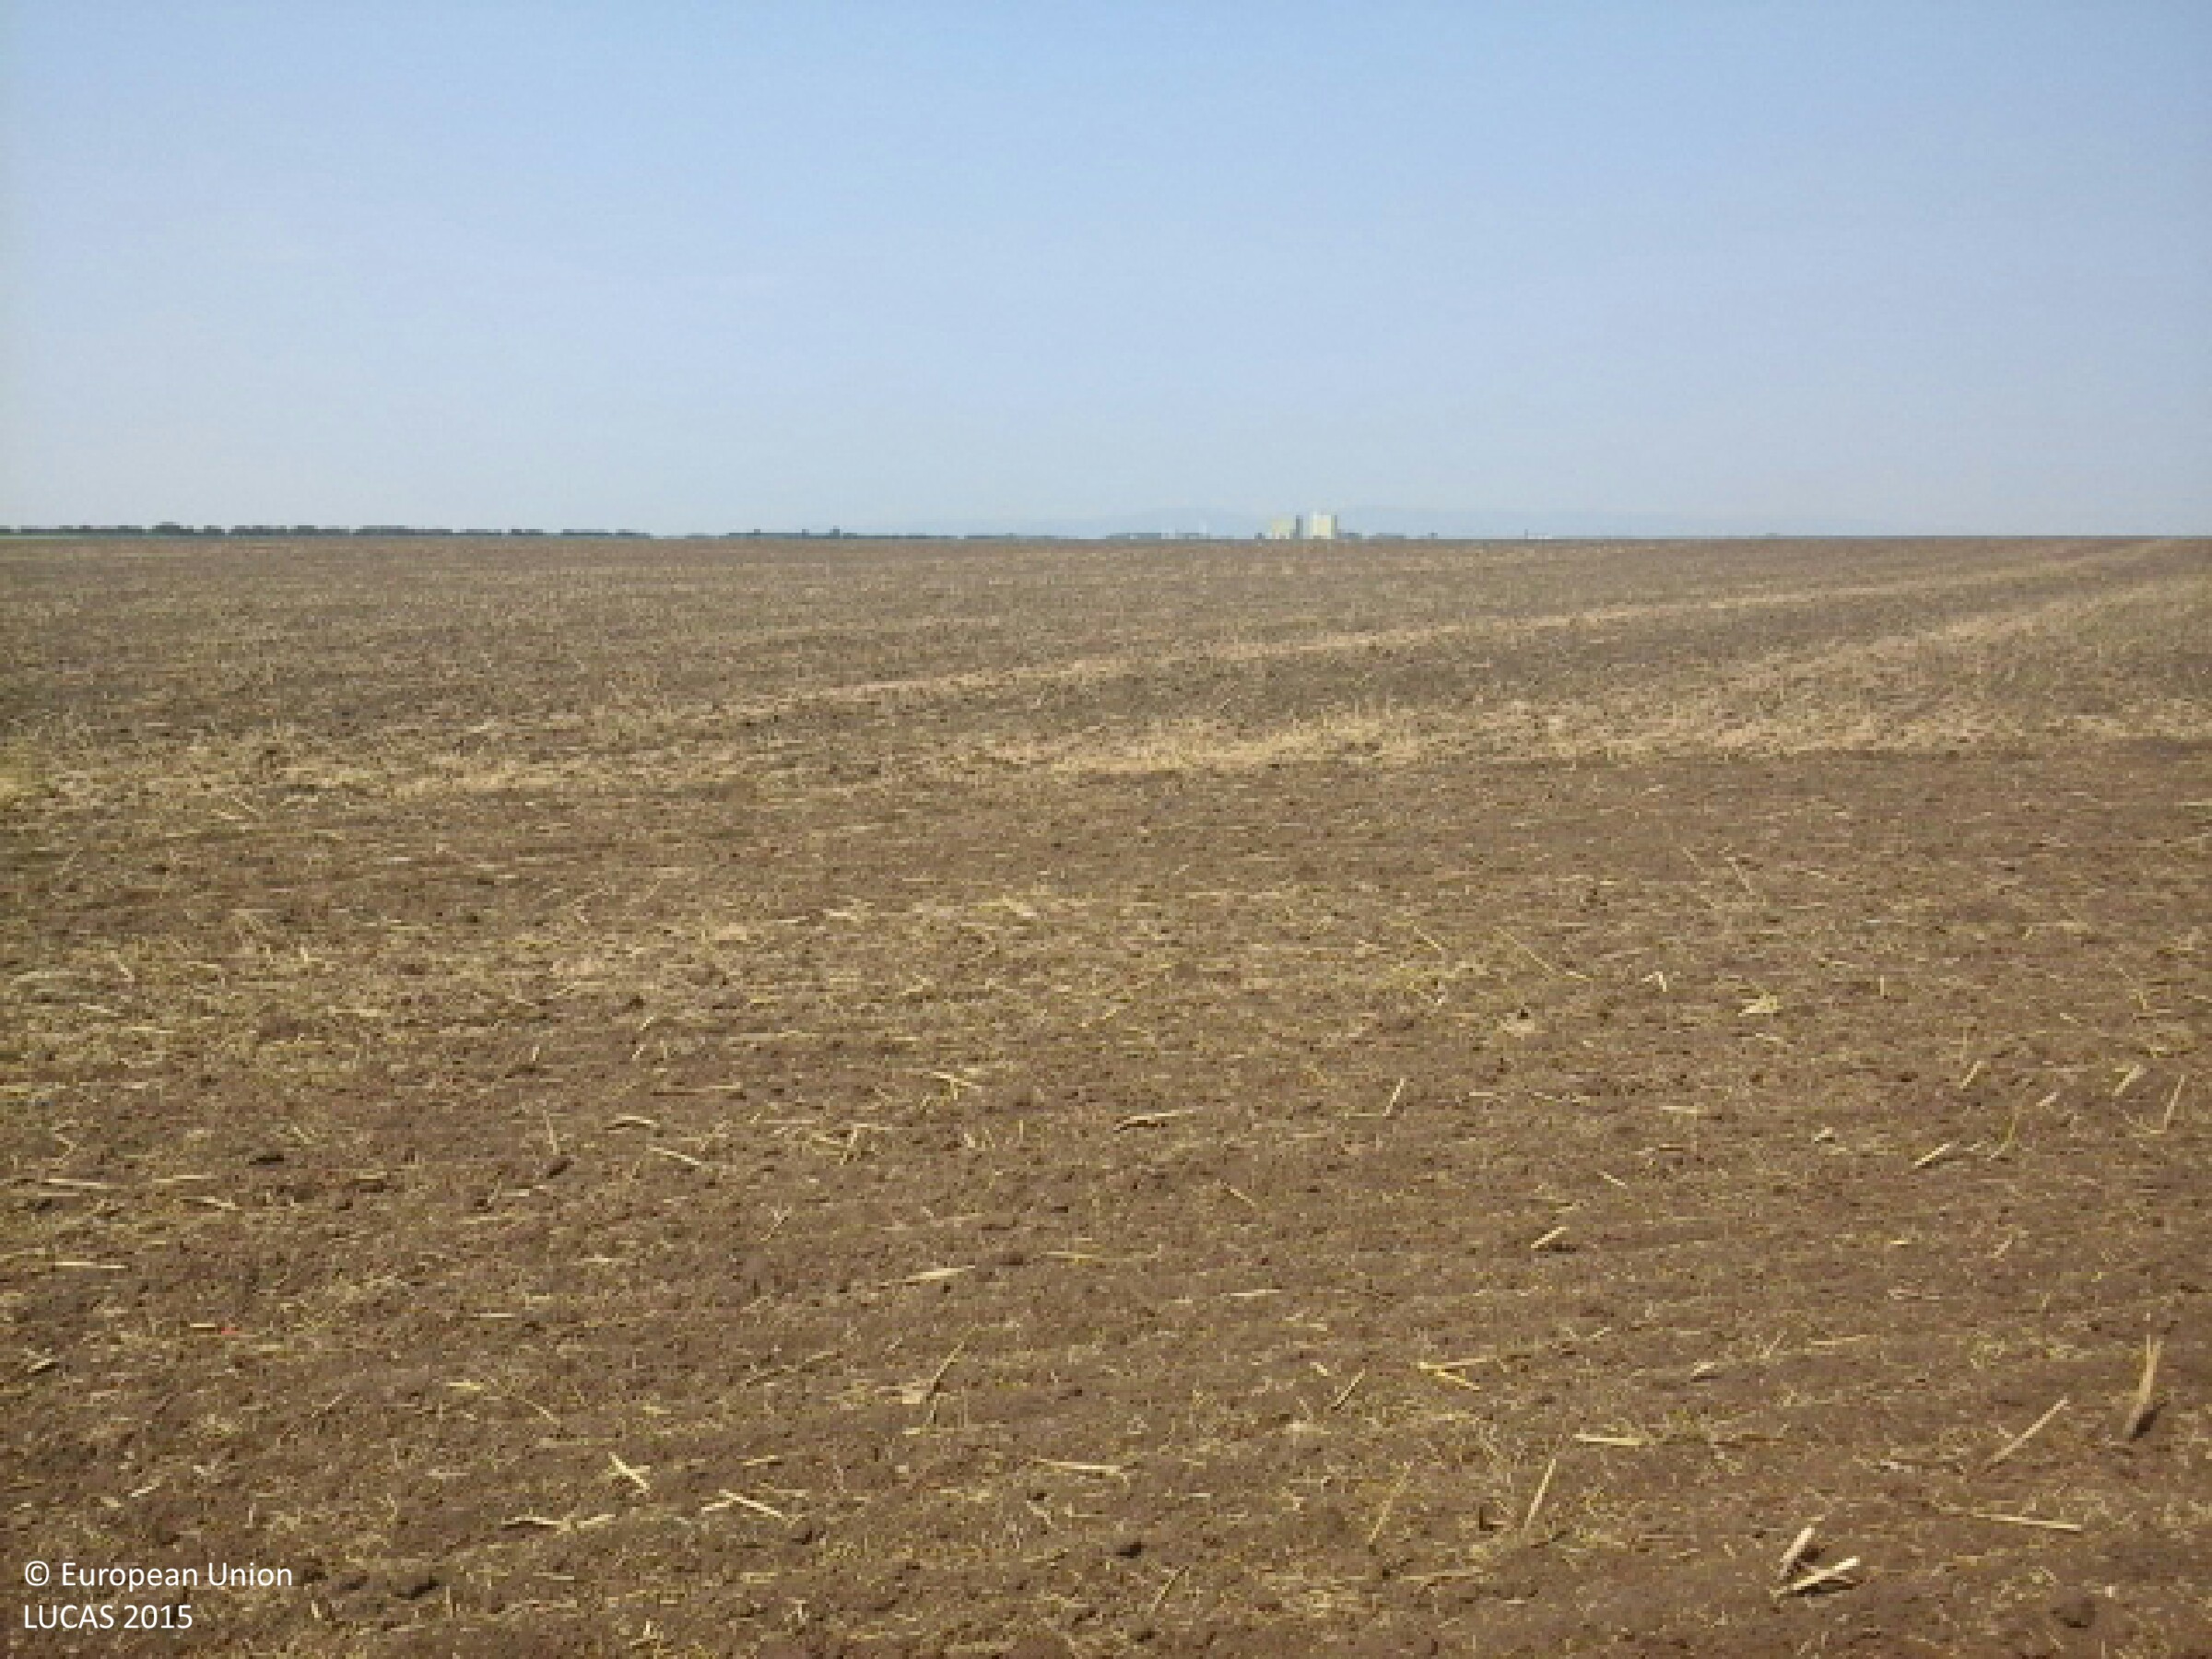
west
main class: Cropland
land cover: Rape and turnip rape
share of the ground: < 10 %
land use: Agriculture (excluding fallow land and kitchen gardens)
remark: Harvested field
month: July
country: HU
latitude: 48.0499
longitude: 21.0267
